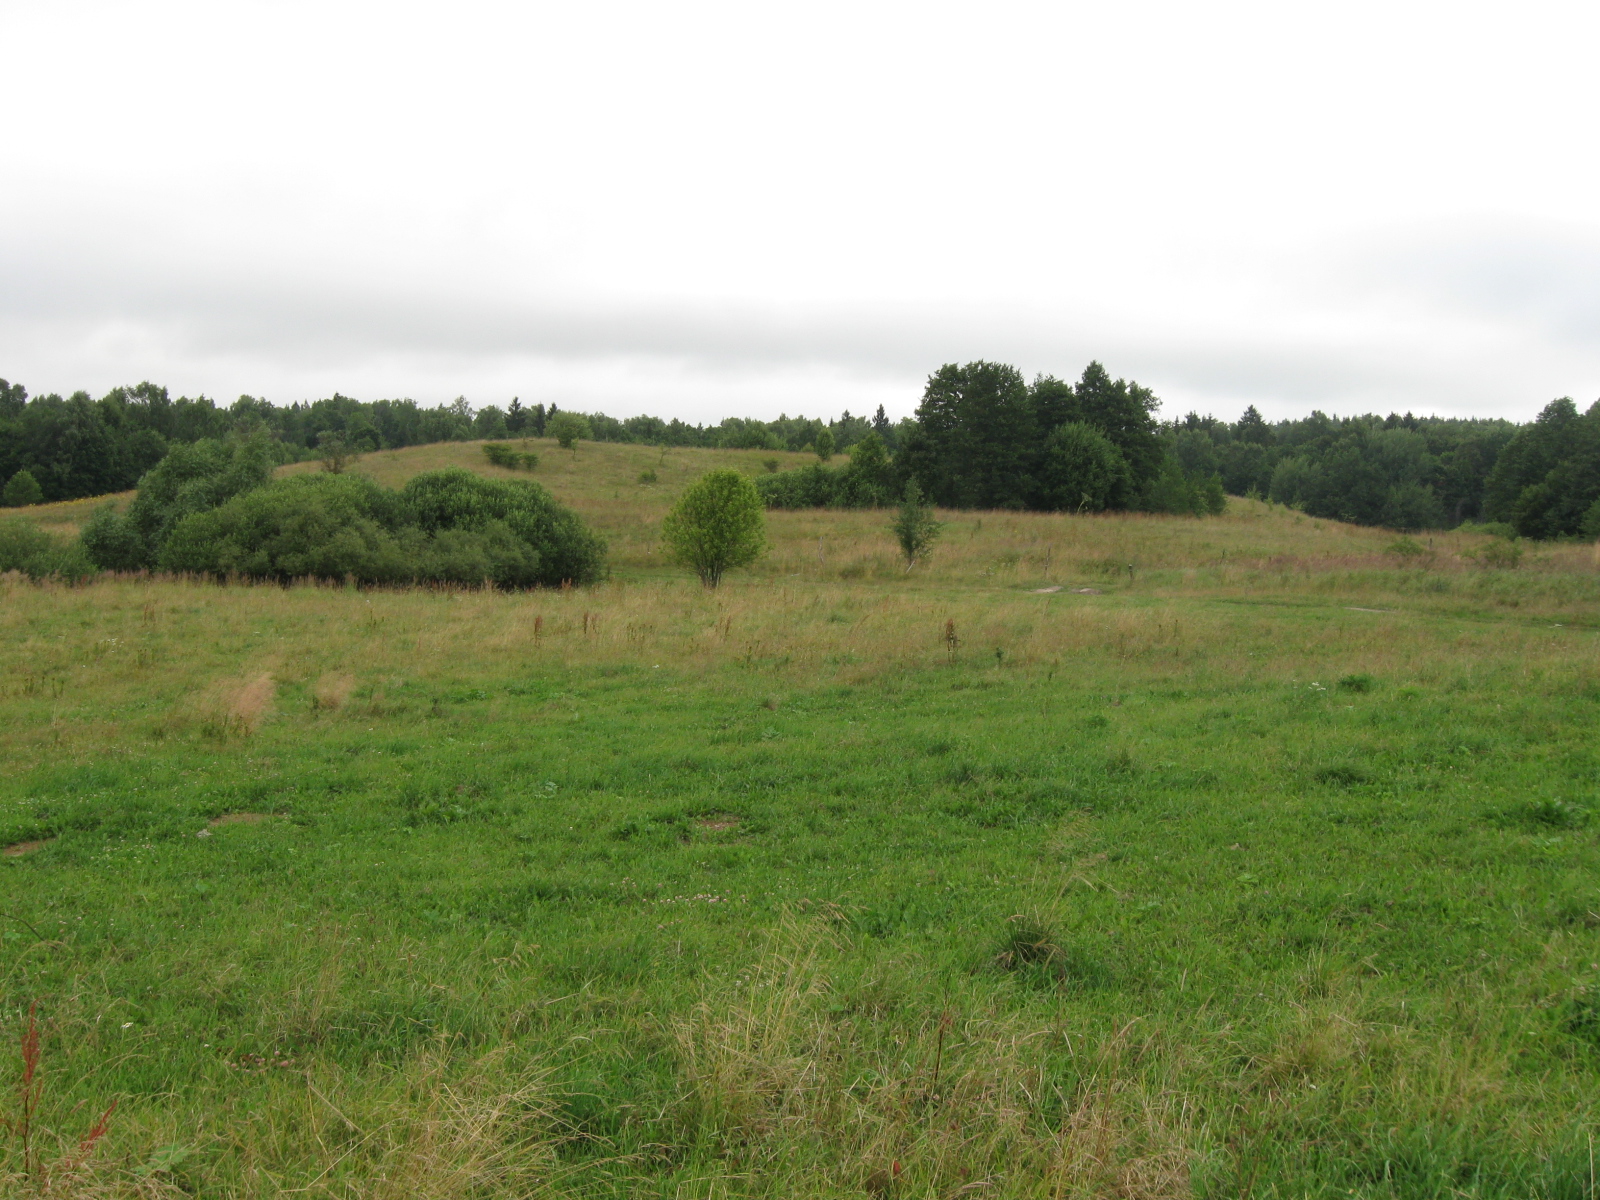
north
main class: Grassland
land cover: Grassland without tree/shrub cover
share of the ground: > 75 %
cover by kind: herbaceous plants 95 %, unconsolidated bare surface 5 %
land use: Agriculture (excluding fallow land and kitchen gardens)
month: July
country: LT
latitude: 54.3953
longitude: 24.2837
